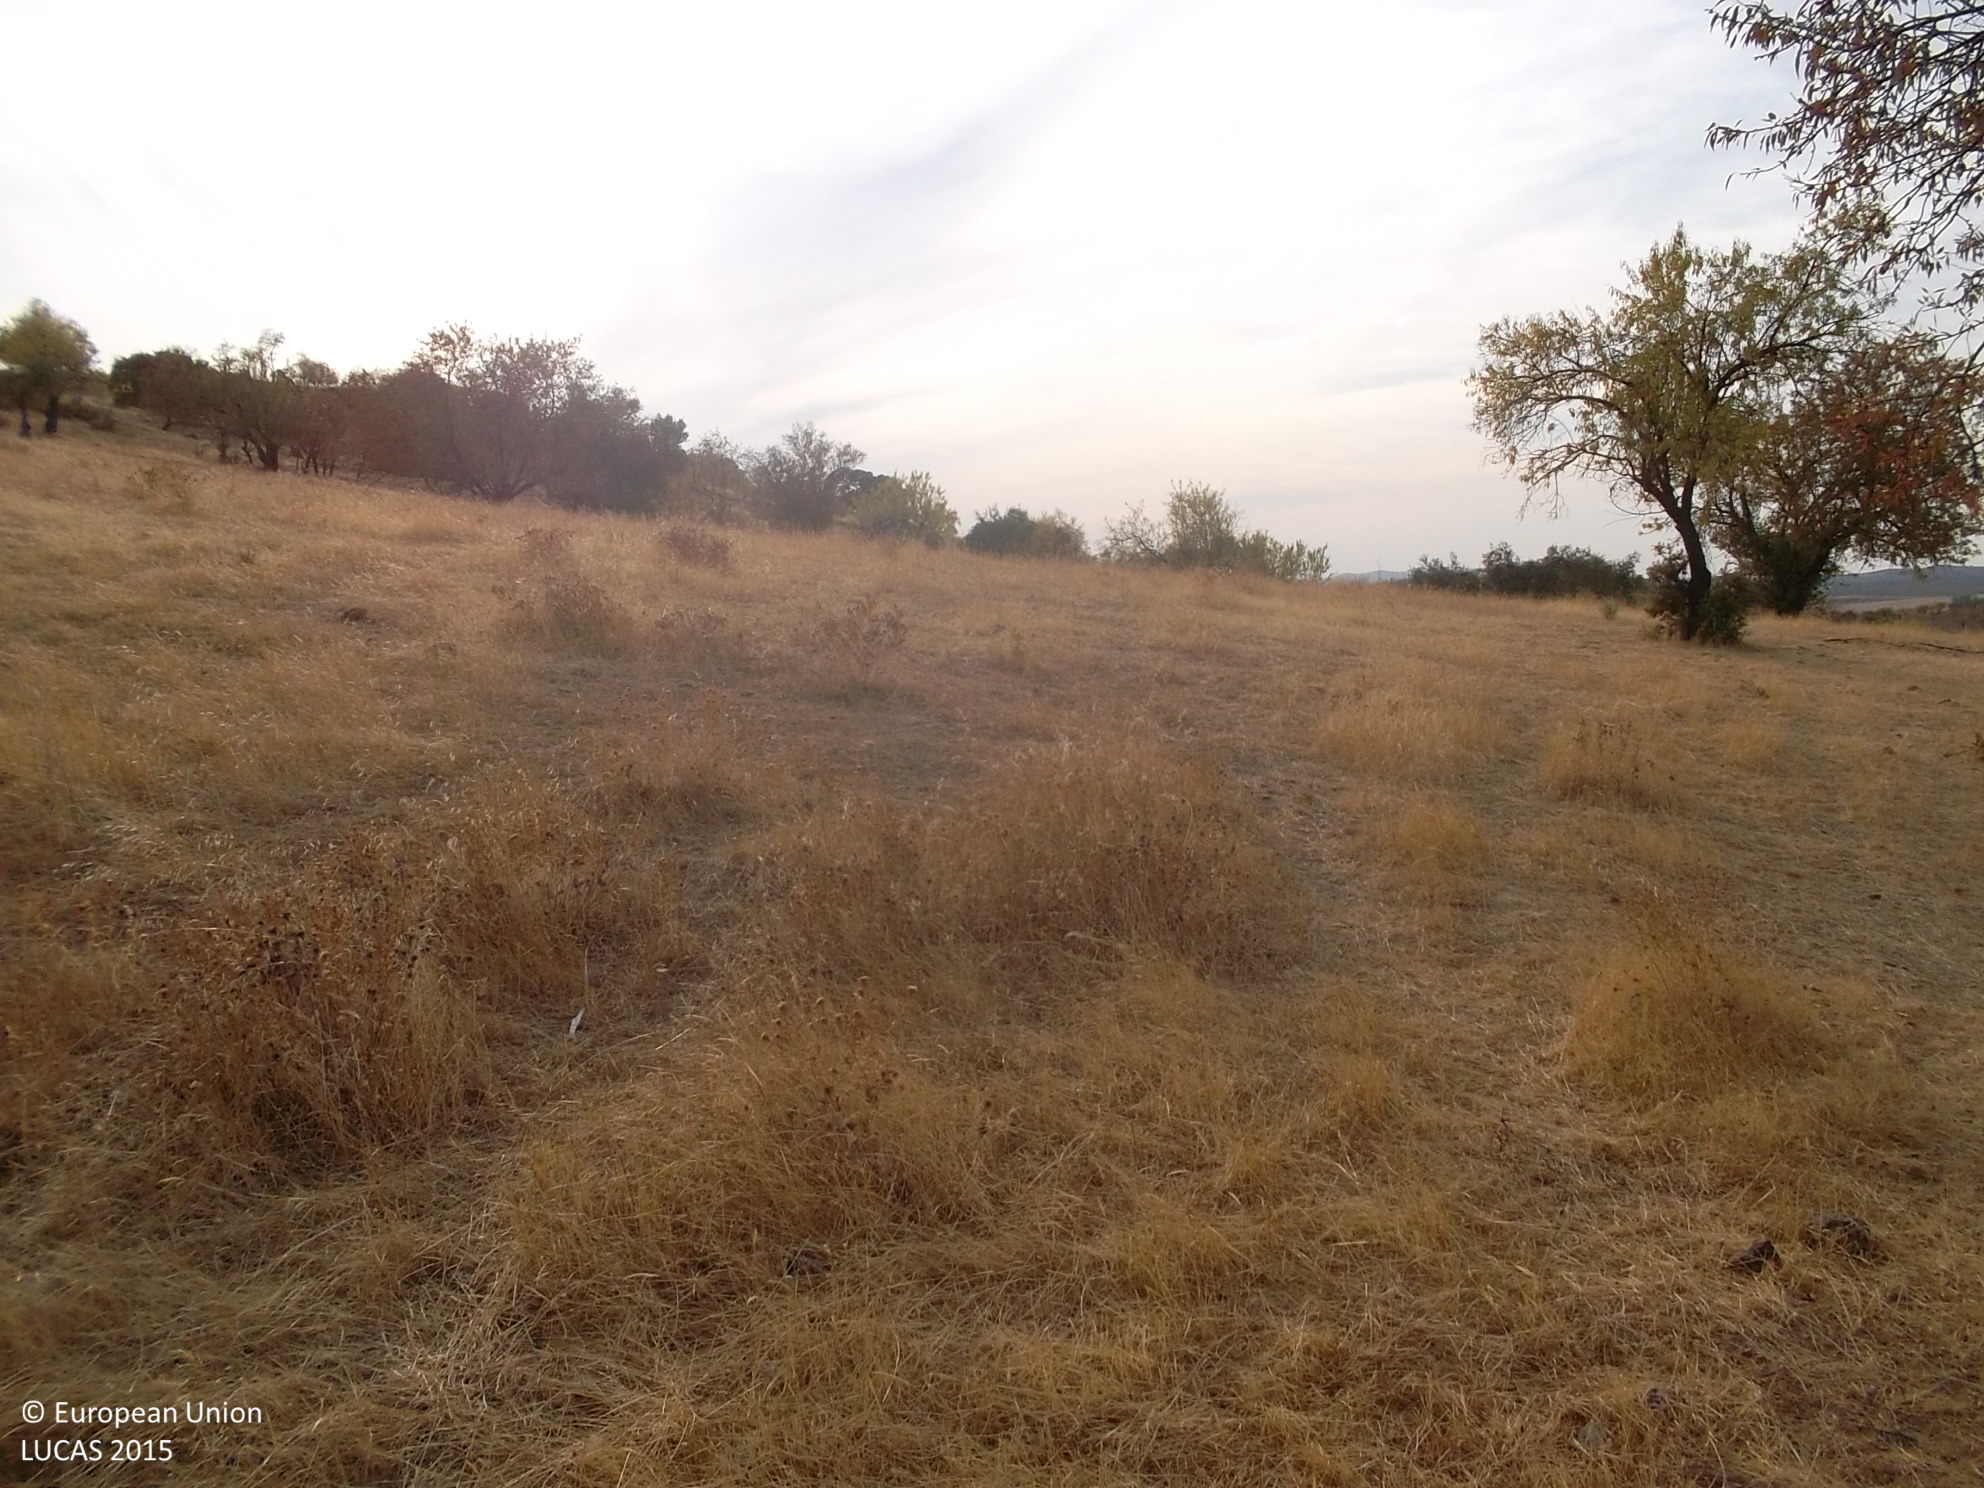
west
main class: Cropland
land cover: Nuts trees
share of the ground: 10 - 25 %
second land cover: Spontaneously vegetated surfaces
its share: > 75 %
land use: Agriculture (excluding fallow land and kitchen gardens)
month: September
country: ES
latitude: 38.4740
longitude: -6.3843
